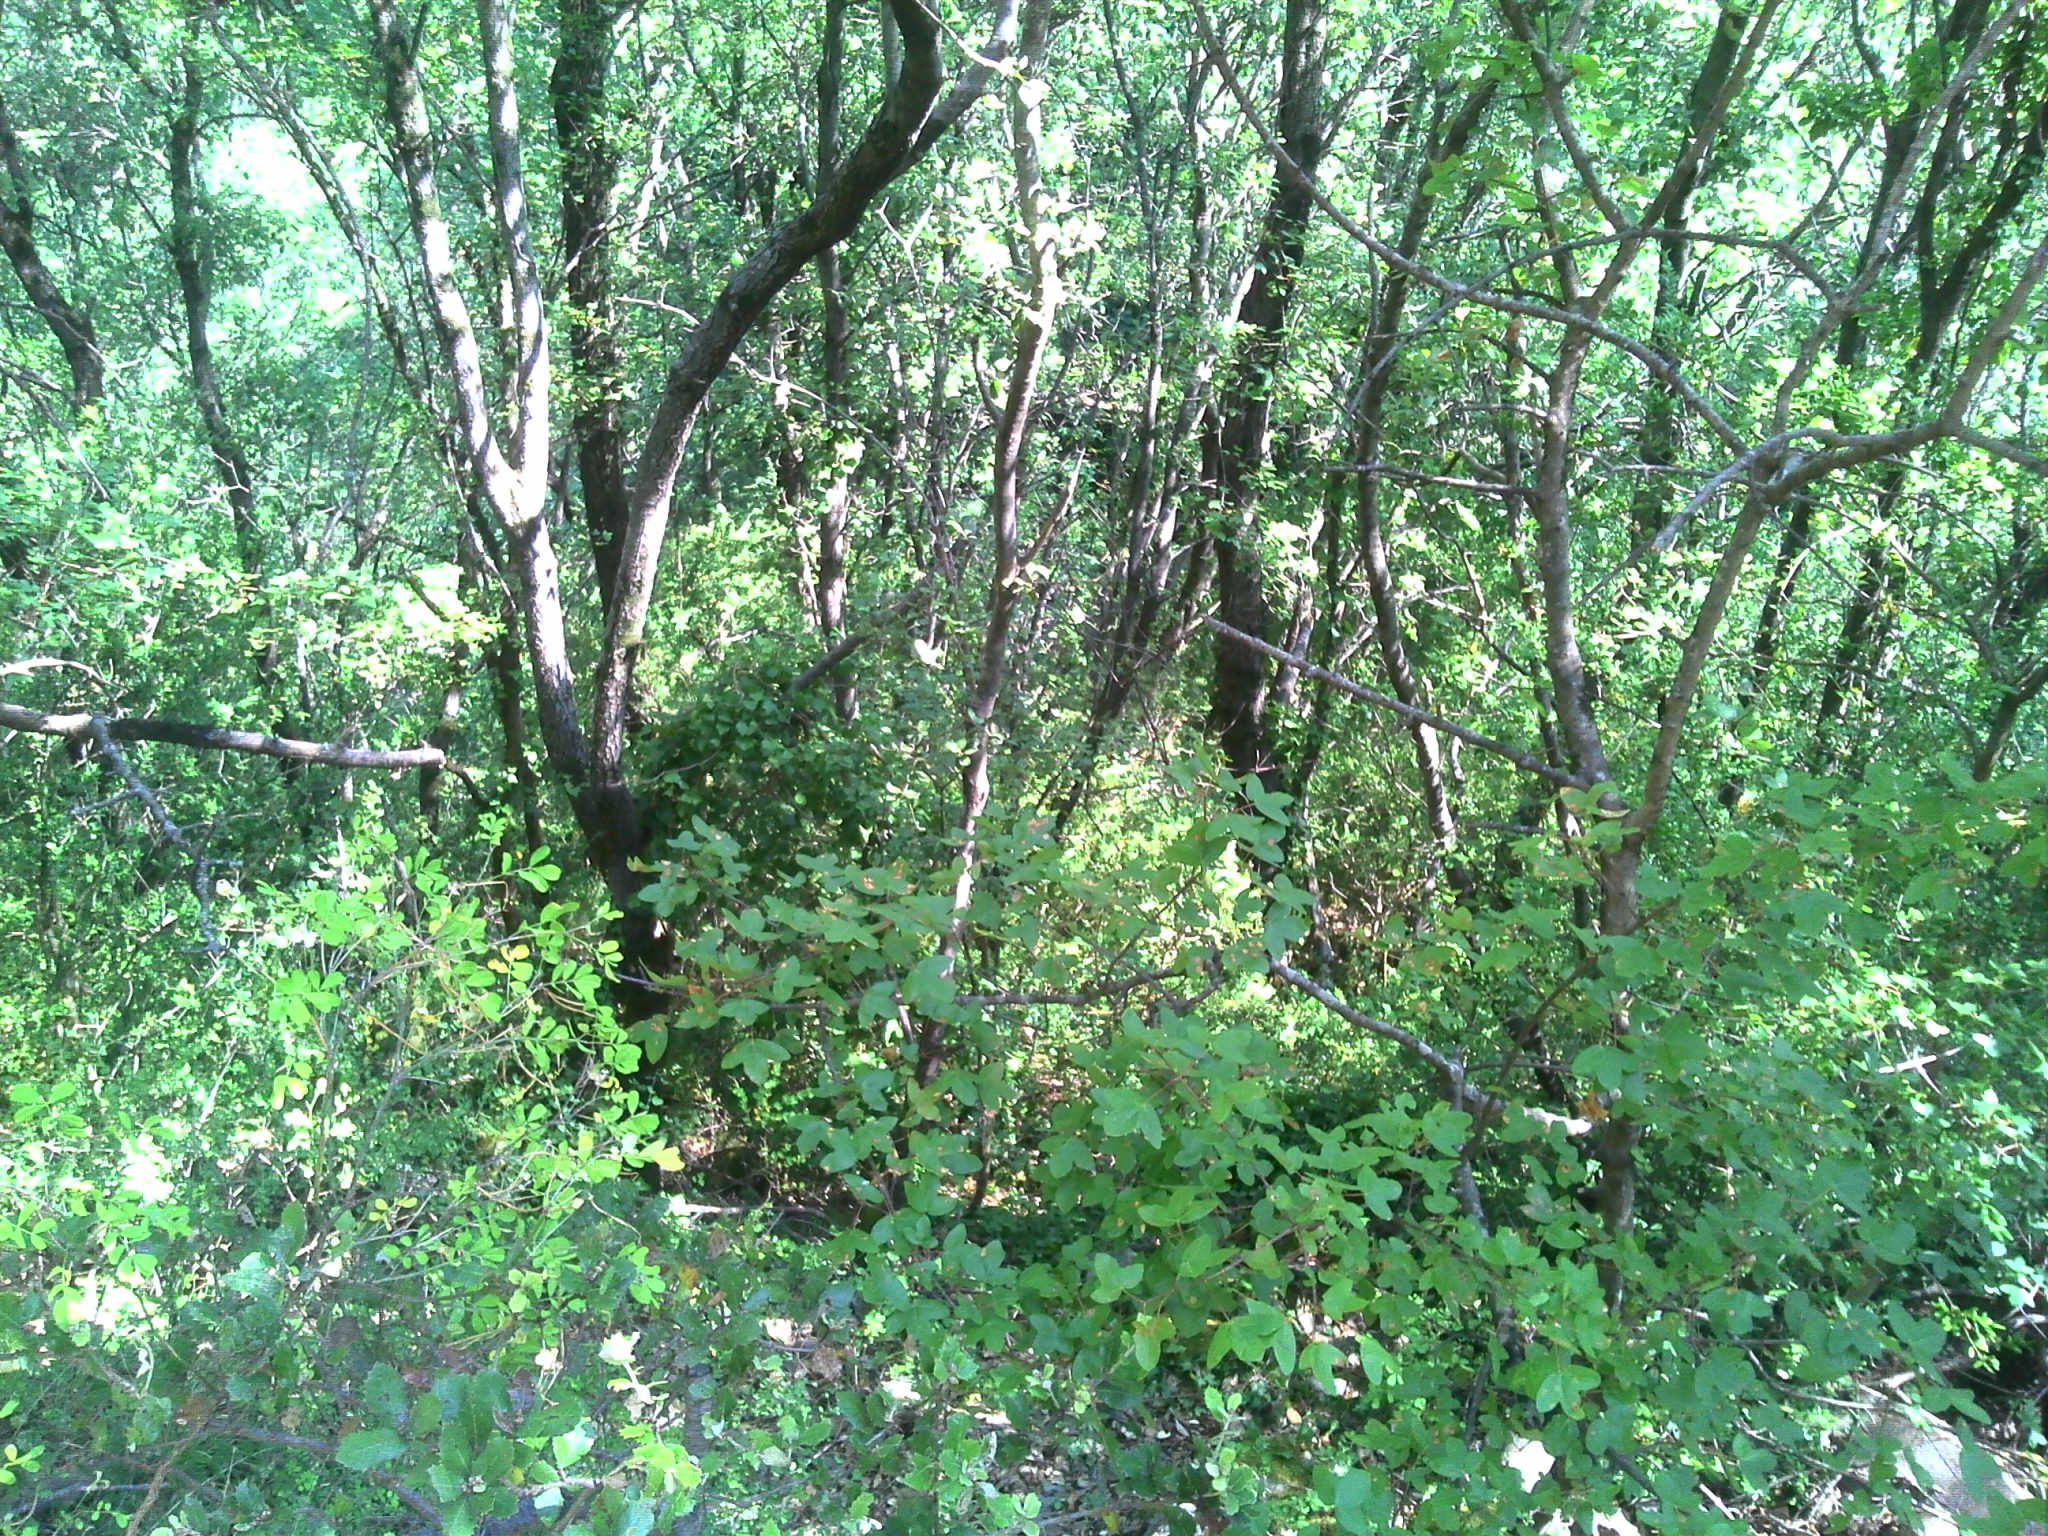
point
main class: Woodland
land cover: Broadleaved woodland
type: broadleaved evergreen forest
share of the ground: > 75 %
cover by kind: broadleaved forest trees 80 %, herbaceous plants 10 %, unconsolidated bare surface 10 %
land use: Forestry
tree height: > 5 m
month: October
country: FR
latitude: 44.0072
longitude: 3.5840
